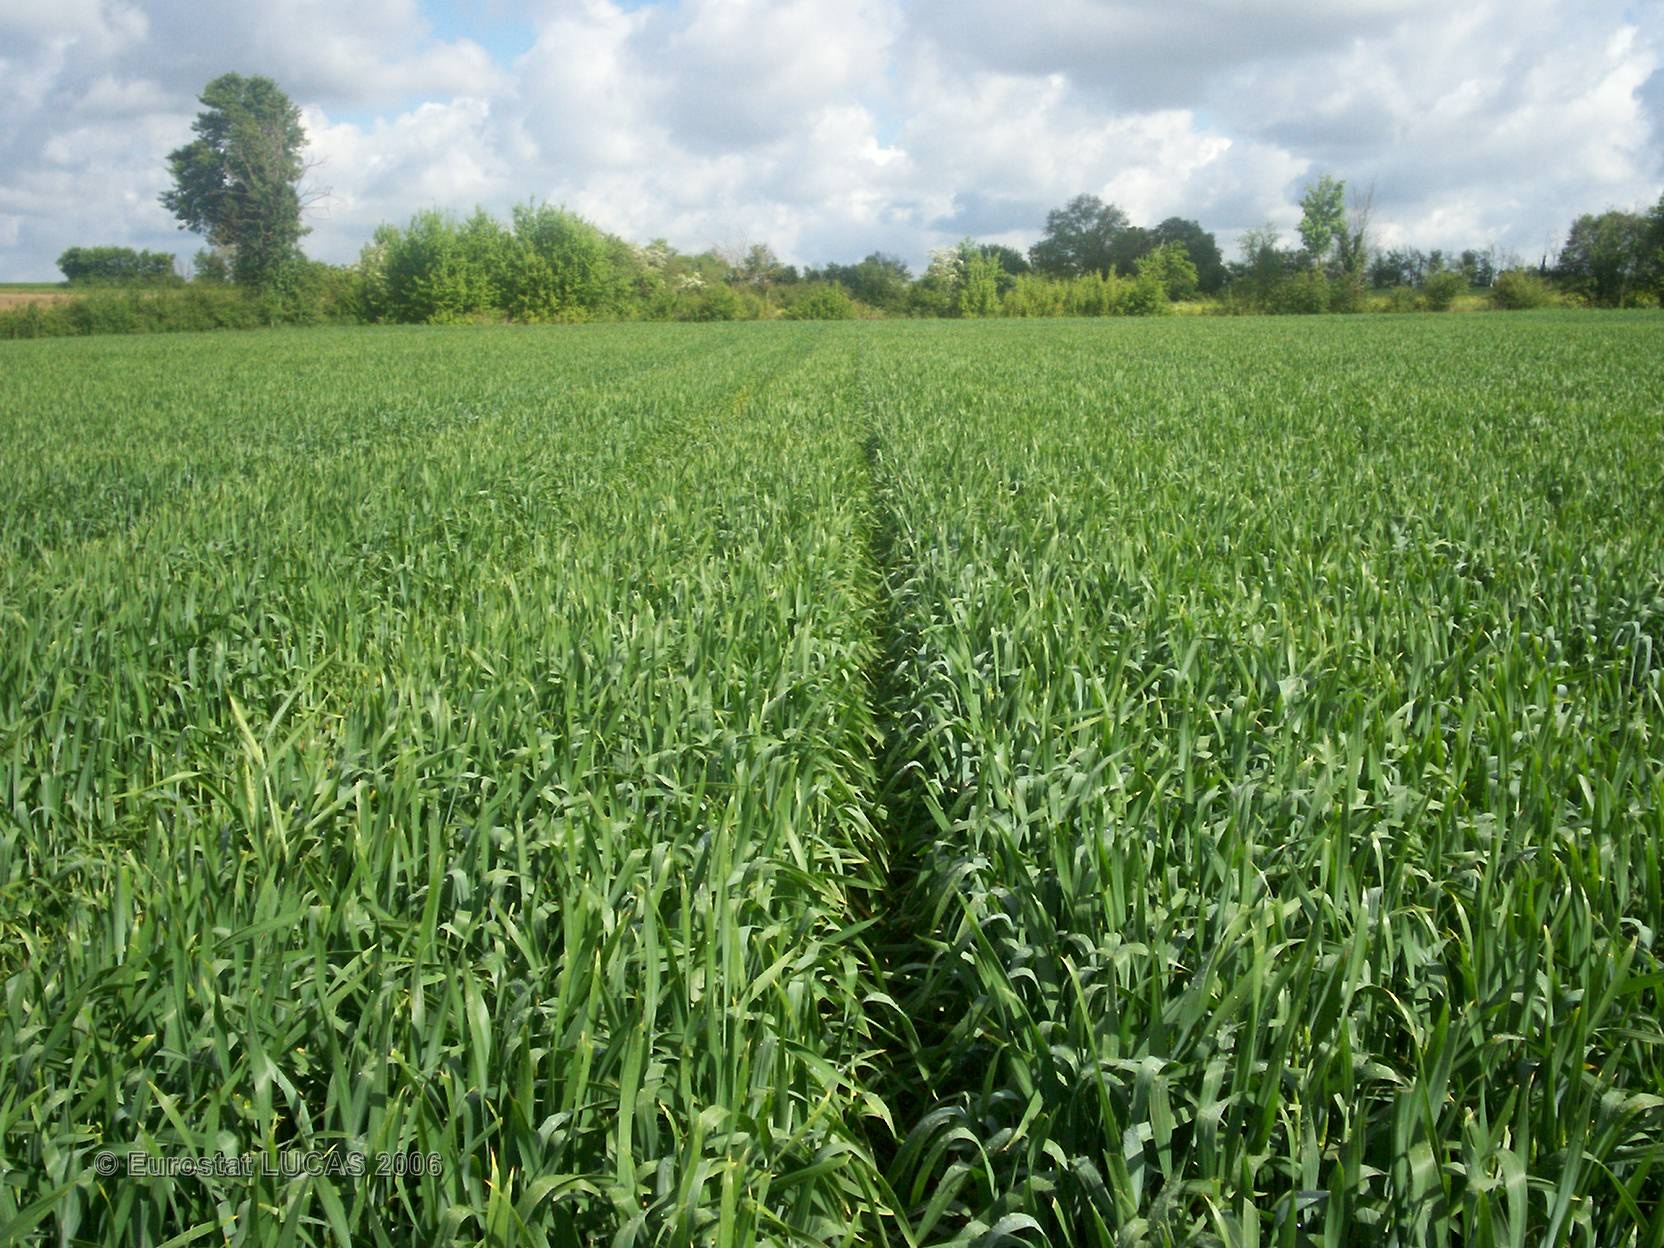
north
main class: Cropland
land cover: Common wheat
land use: Agriculture (excluding fallow land and kitchen gardens)
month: May
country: FR
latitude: 46.3455
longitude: 0.5110
